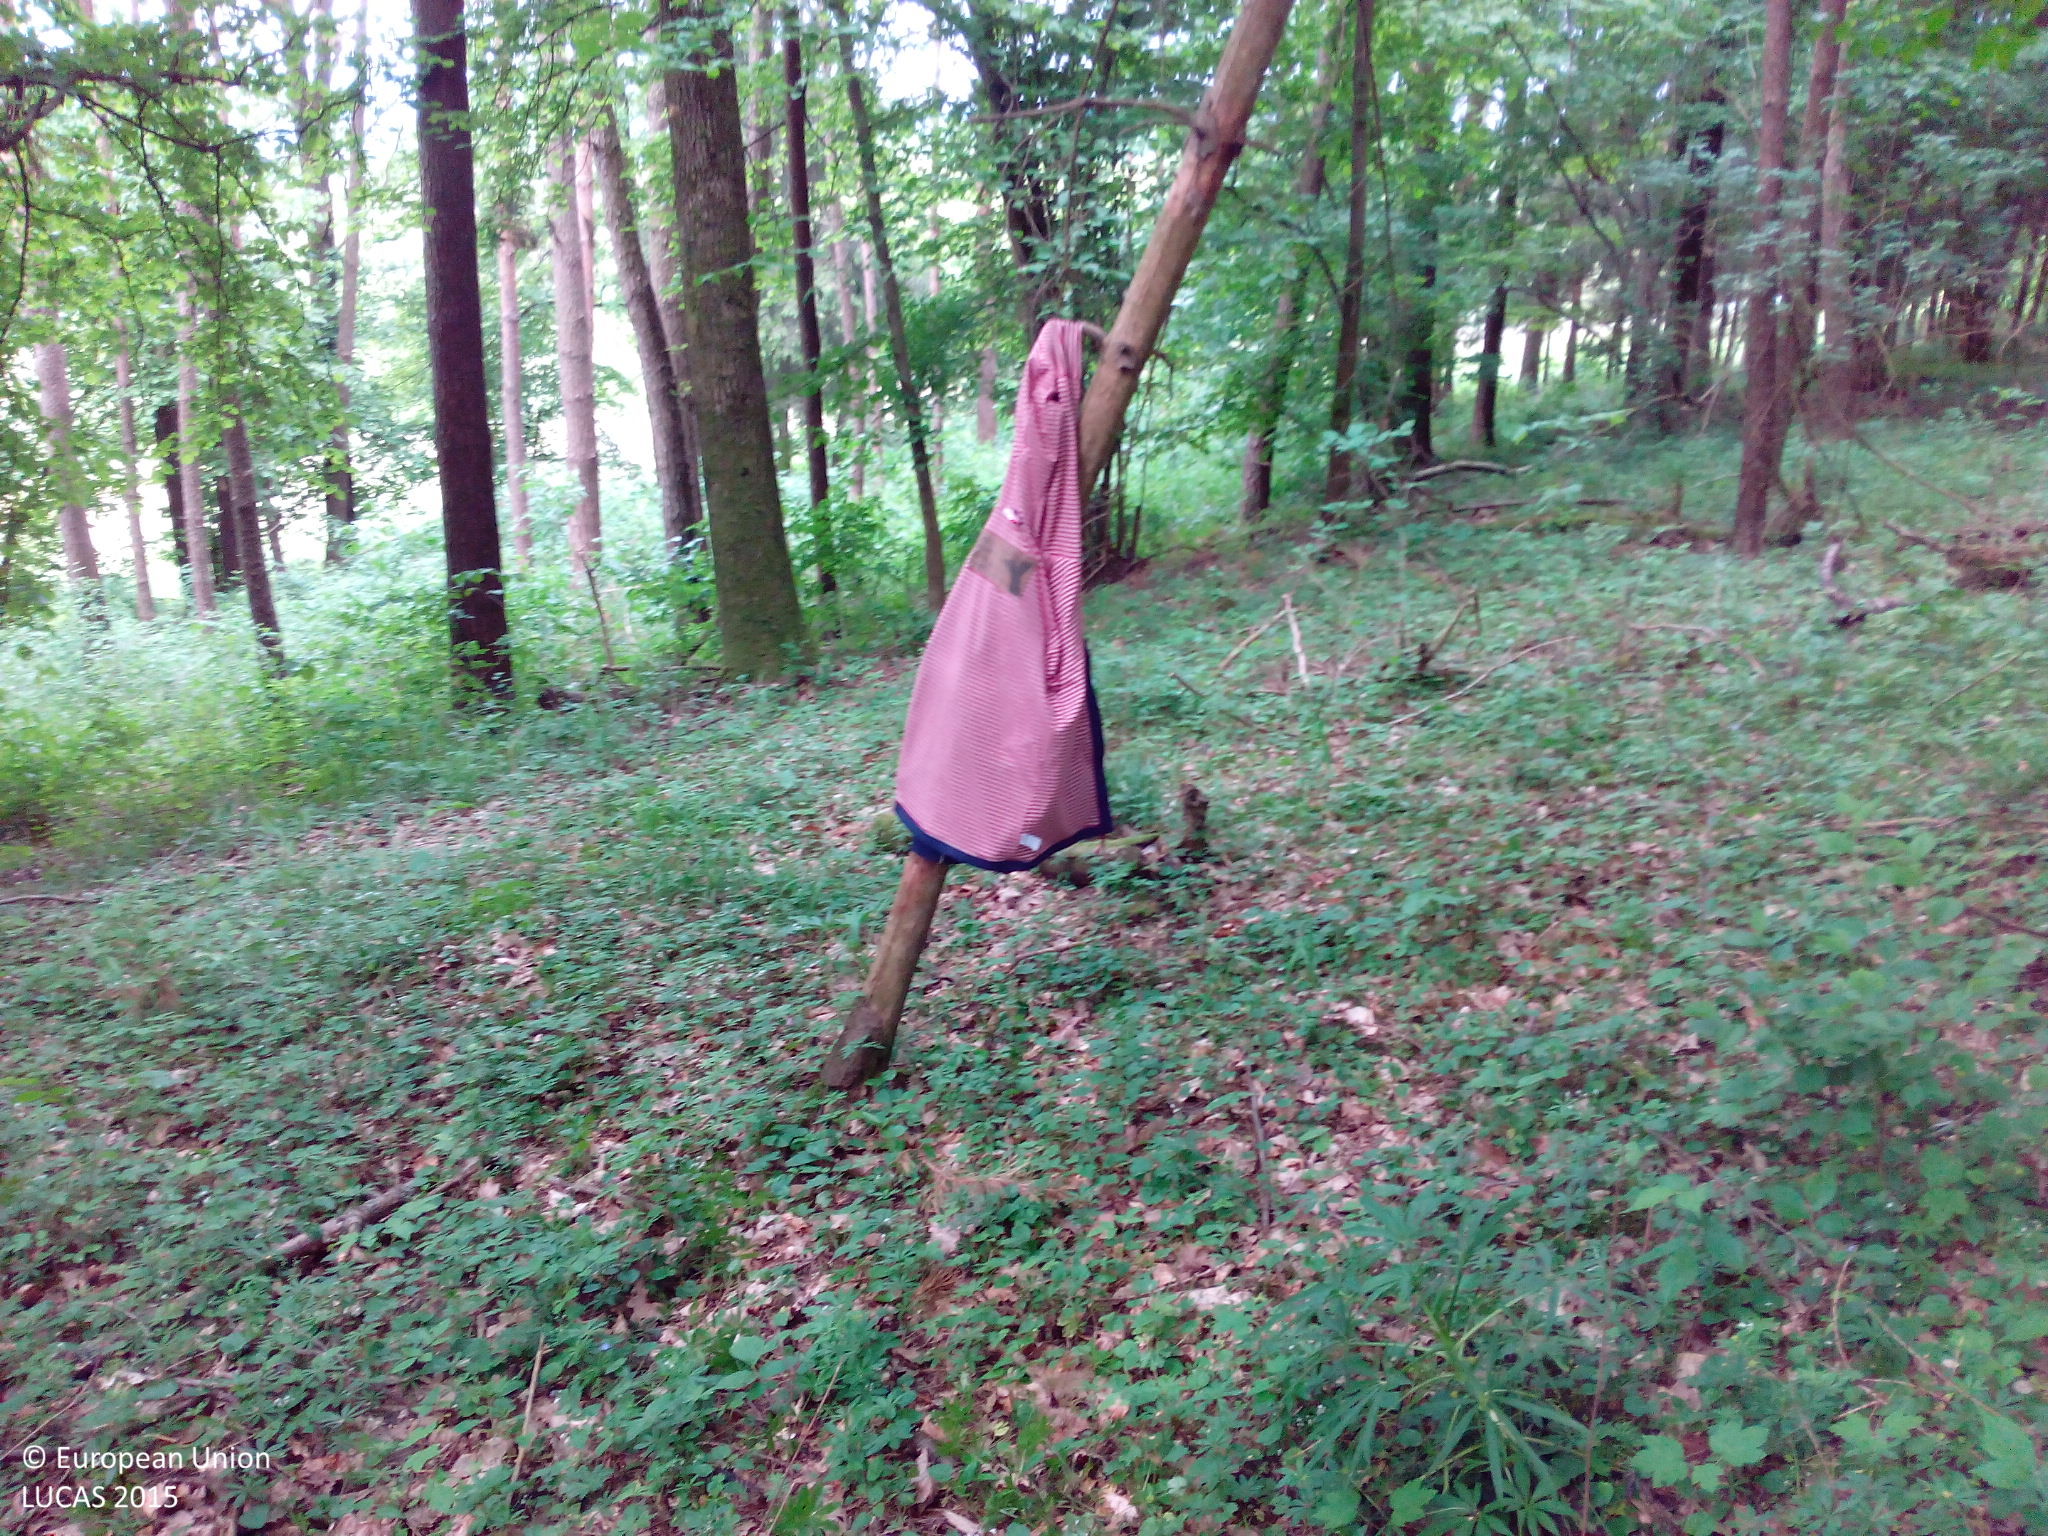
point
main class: Woodland
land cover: Pine dominated mixed woodland
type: hemiboreal forest and nemoral coniferous forest and mixed broadleaved-coniferous forest
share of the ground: > 75 %
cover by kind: coniferous forest trees 60 %, broadleaved forest trees 30 %, shrubs 5 %, herbaceous plants 5 %
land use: Semi-natural and natural areas not in use
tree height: > 5 m
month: May
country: DE
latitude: 49.3720
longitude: 9.1878
